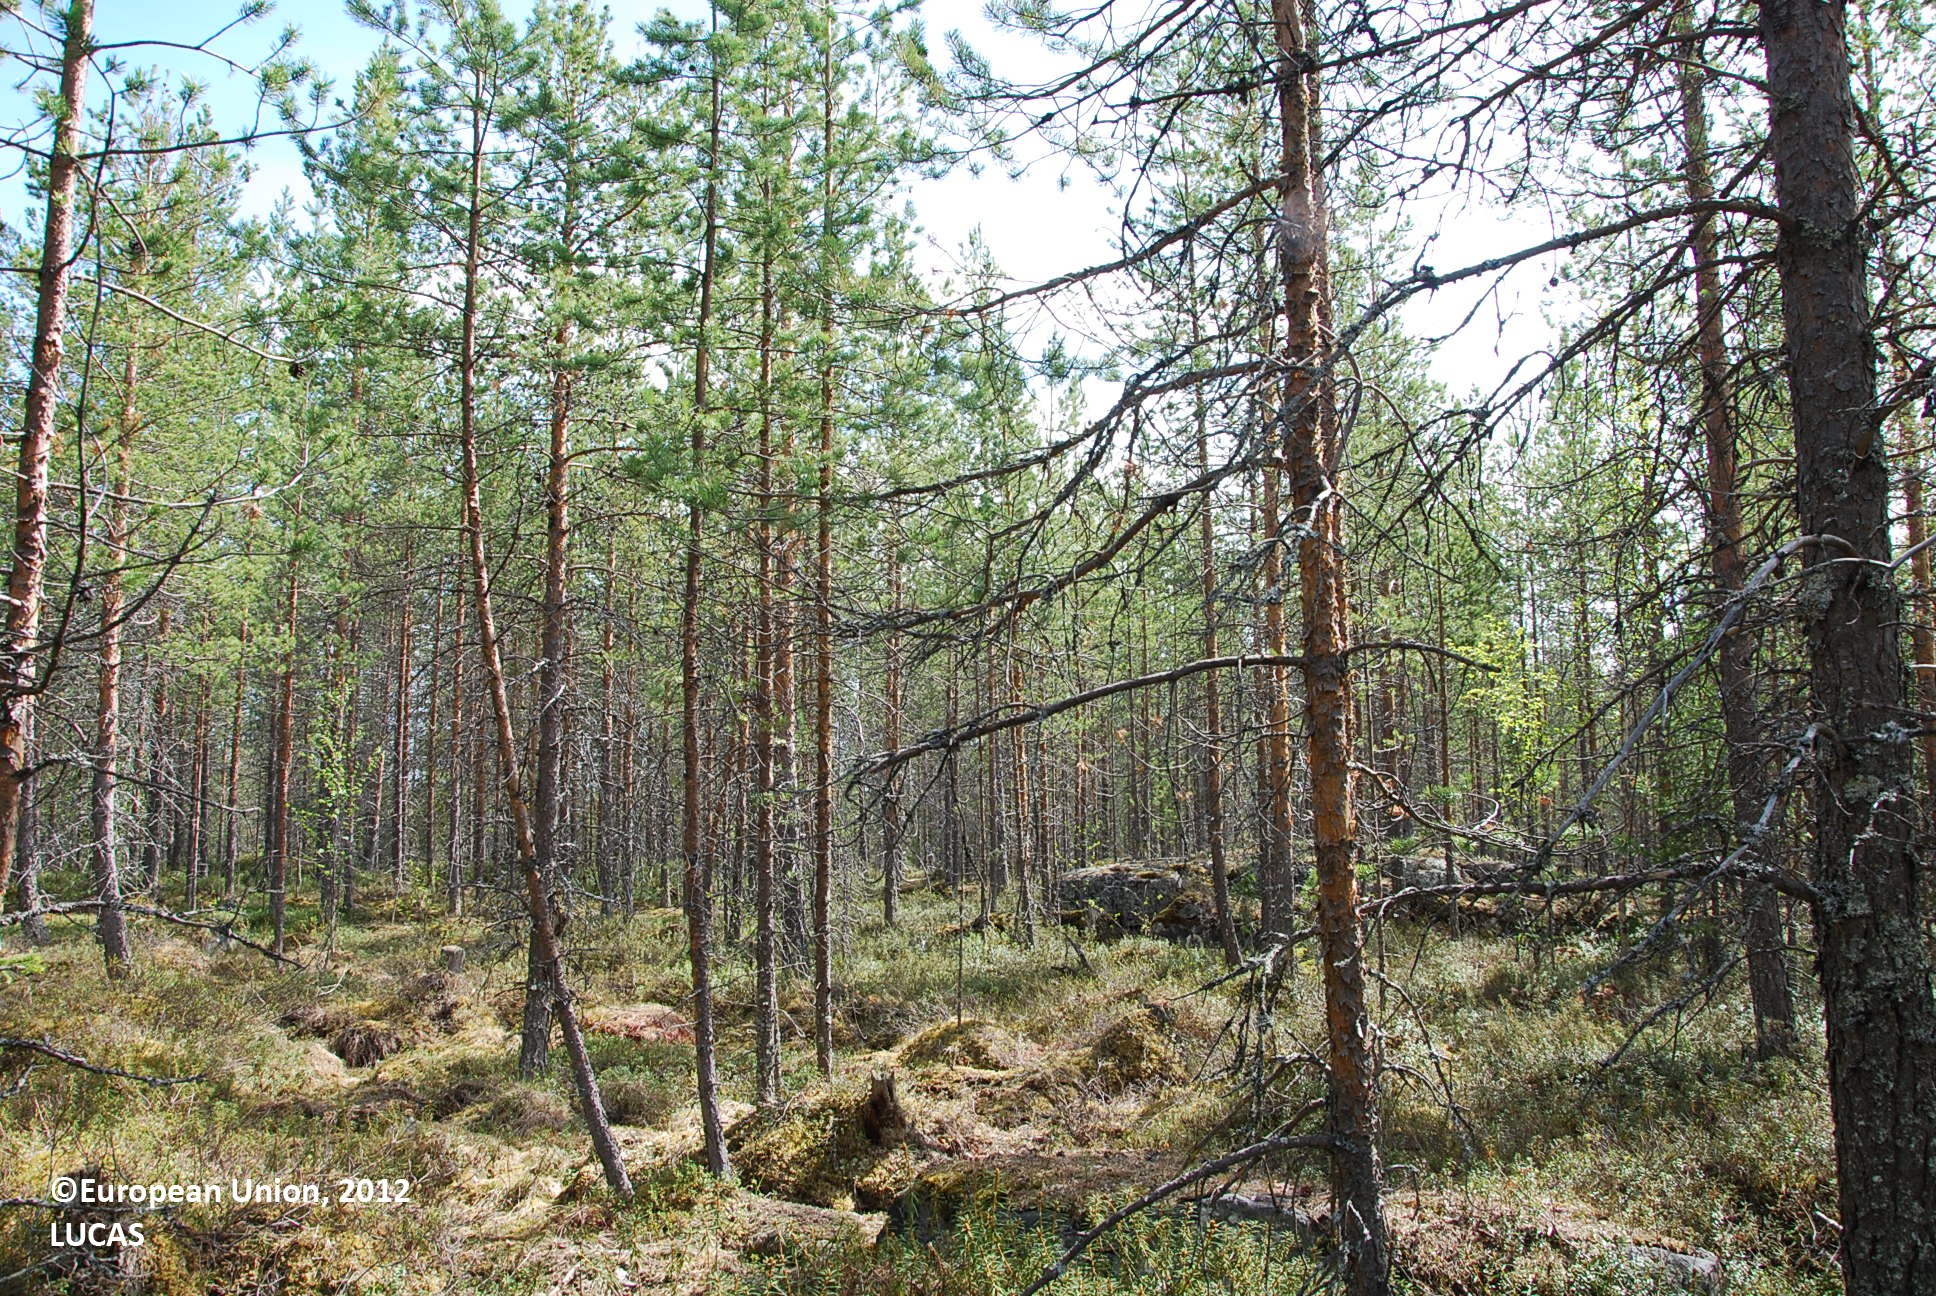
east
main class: Woodland
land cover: Pine dominated coniferous woodland
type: boreal forest
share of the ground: > 75 %
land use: Forestry
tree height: > 5 m
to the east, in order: Pine dominated coniferous woodland; Tracks; Pine dominated coniferous woodland
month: June
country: FI
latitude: 66.6011
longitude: 28.0230
